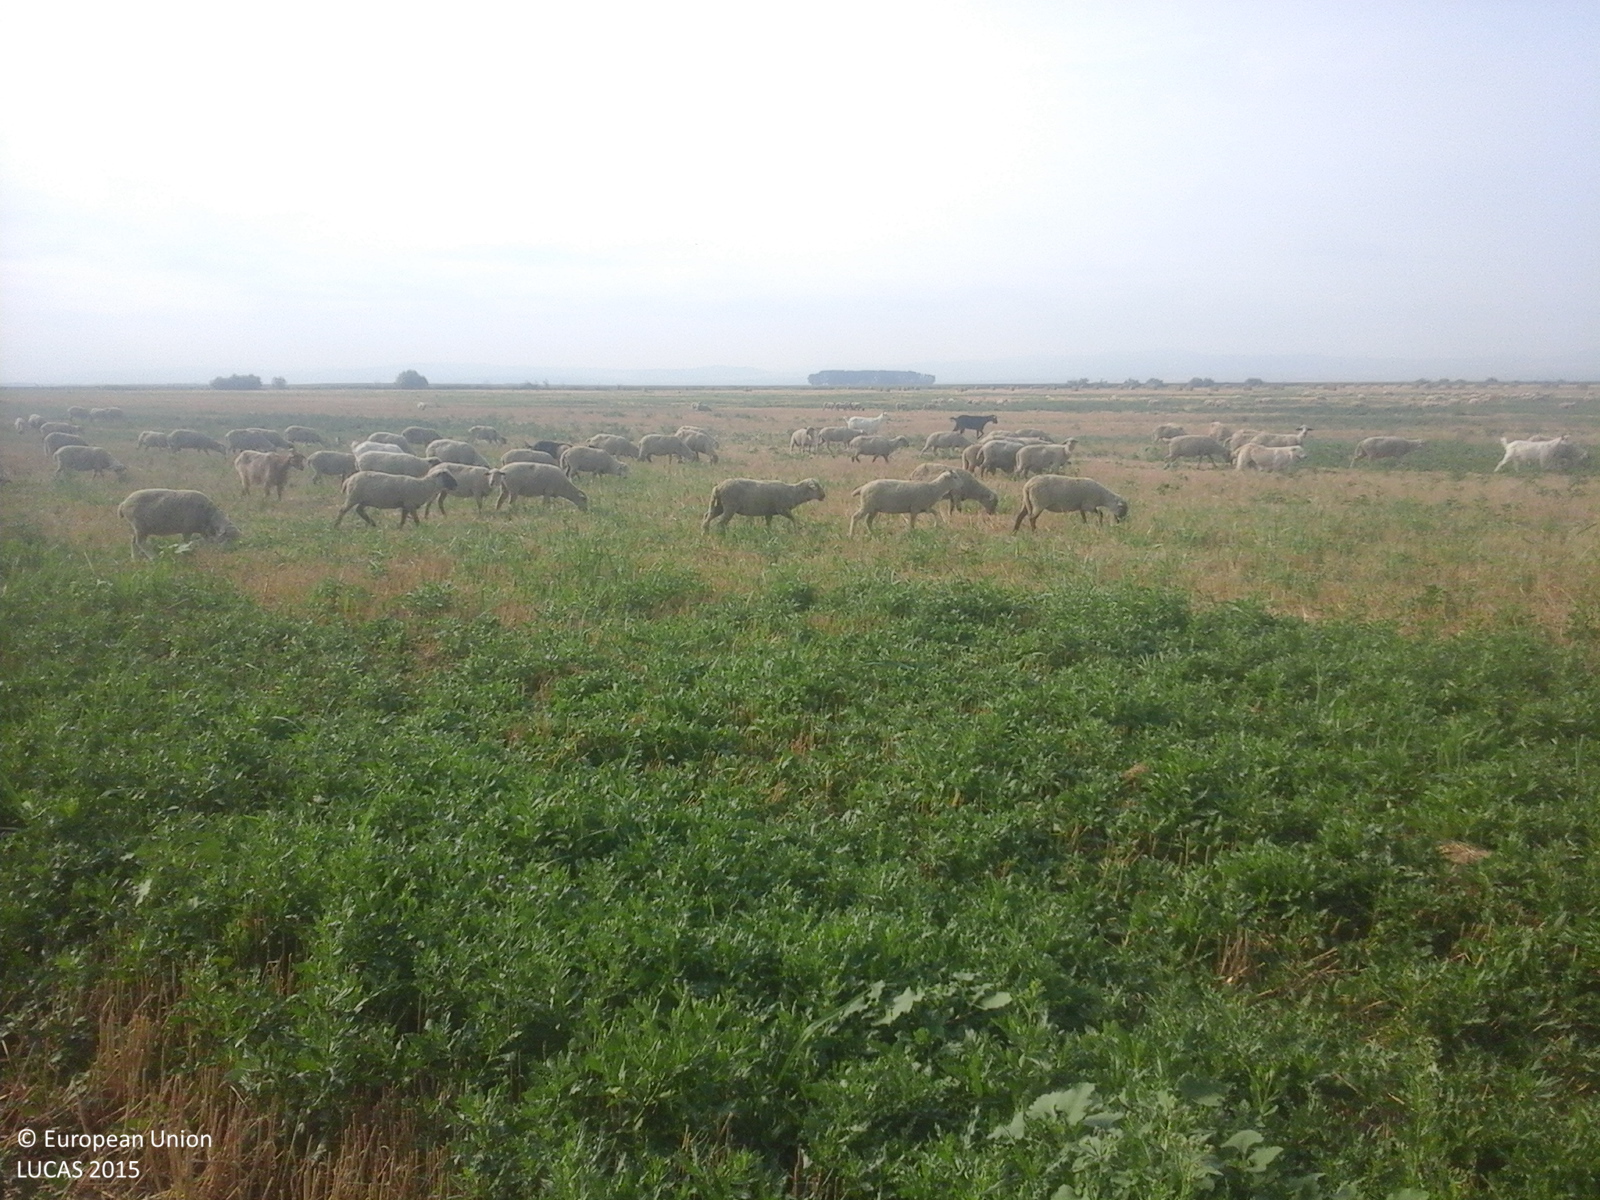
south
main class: Cropland
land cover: Durum wheat
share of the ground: > 75 %
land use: Agriculture (excluding fallow land and kitchen gardens)
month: July
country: RO
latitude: 45.3911
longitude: 28.2496
